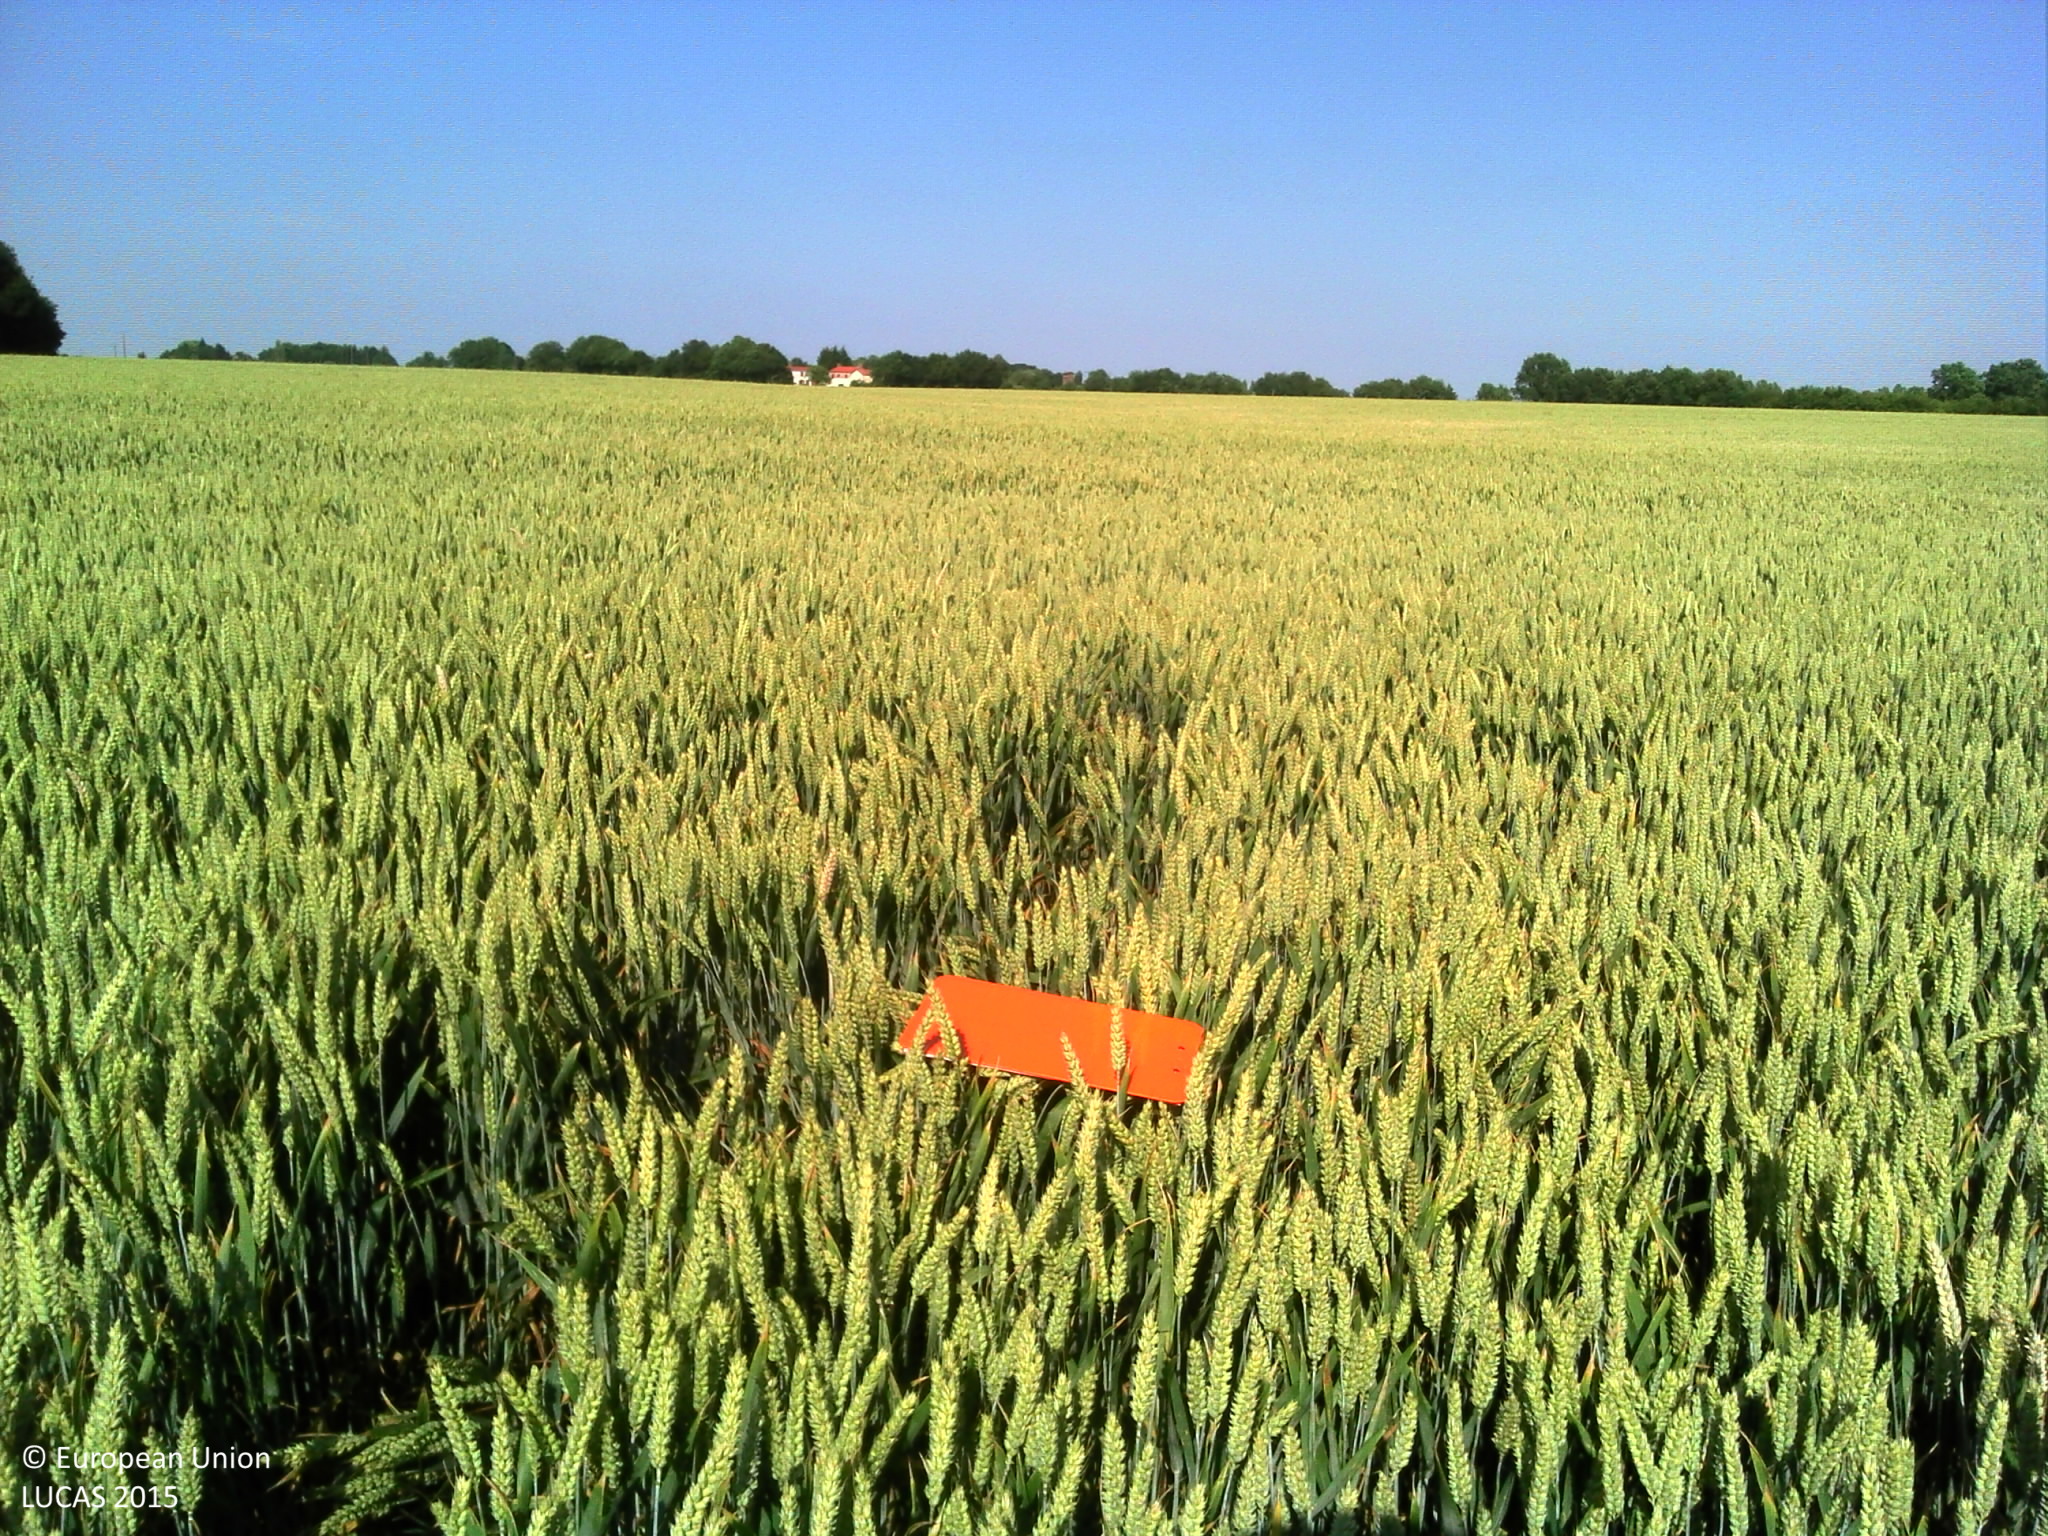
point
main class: Cropland
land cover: Common wheat
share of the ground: > 75 %
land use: Agriculture (excluding fallow land and kitchen gardens)
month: June
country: FR
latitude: 46.8887
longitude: -1.3641
